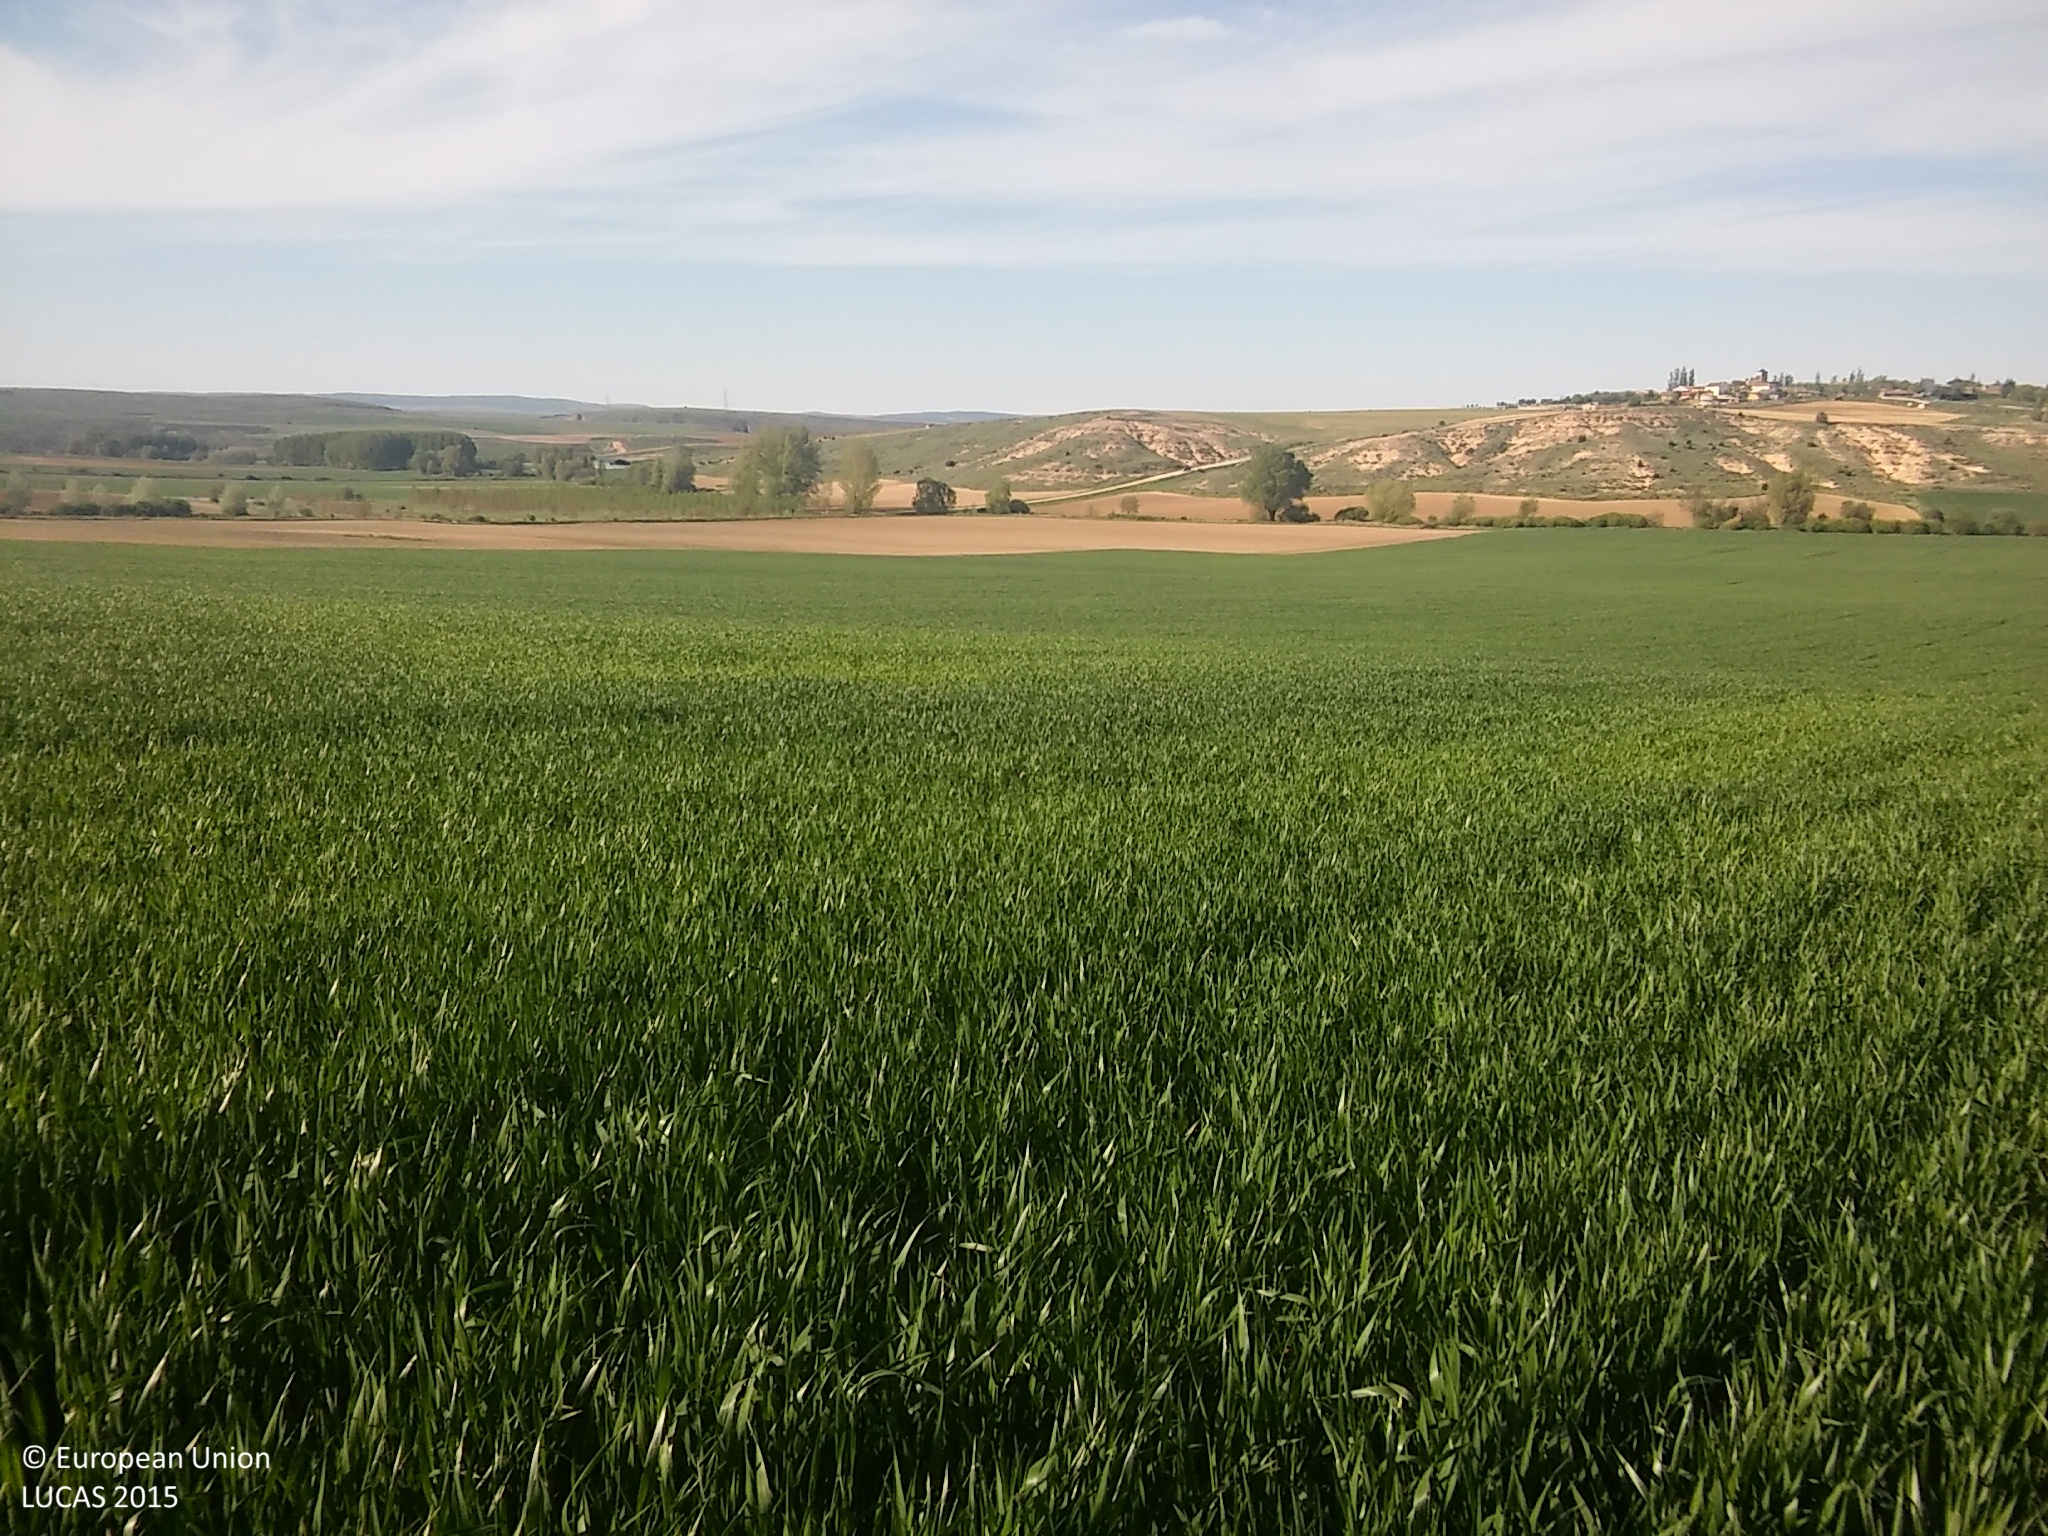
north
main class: Cropland
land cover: Common wheat
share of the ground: > 75 %
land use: Agriculture (excluding fallow land and kitchen gardens)
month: May
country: ES
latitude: 41.2588
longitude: -3.7141
